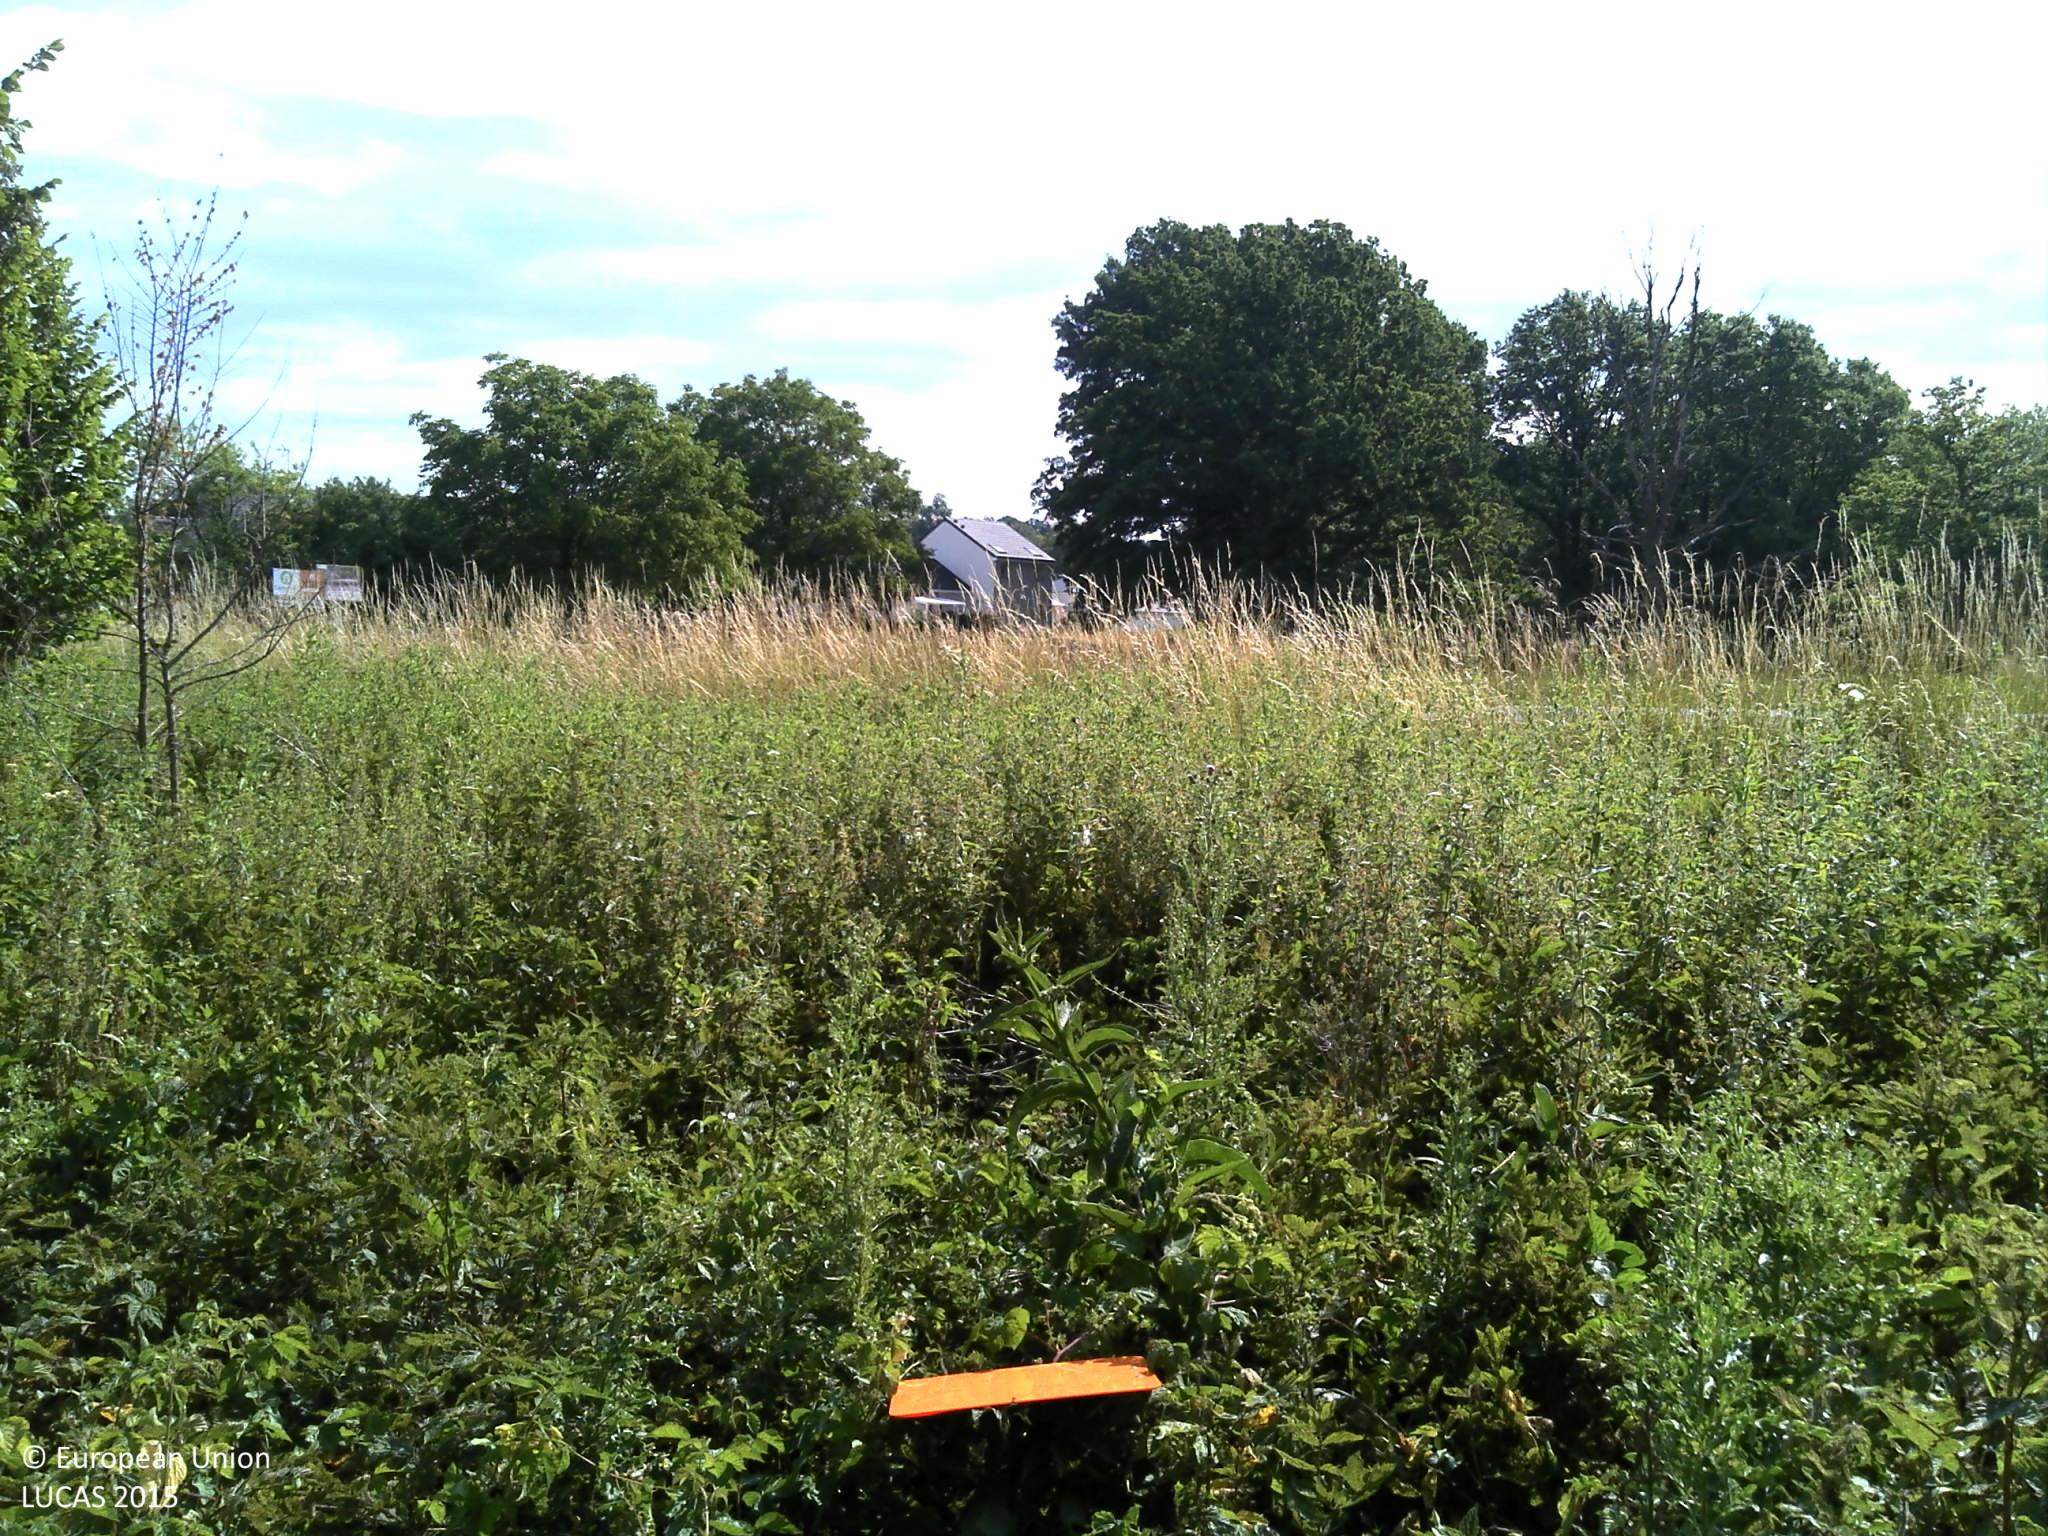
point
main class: Grassland
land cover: Spontaneously vegetated surfaces
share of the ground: > 75 %
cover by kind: herbaceous plants 100 %
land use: Abandoned areas
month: July
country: FR
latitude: 49.7192
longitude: 4.7122
